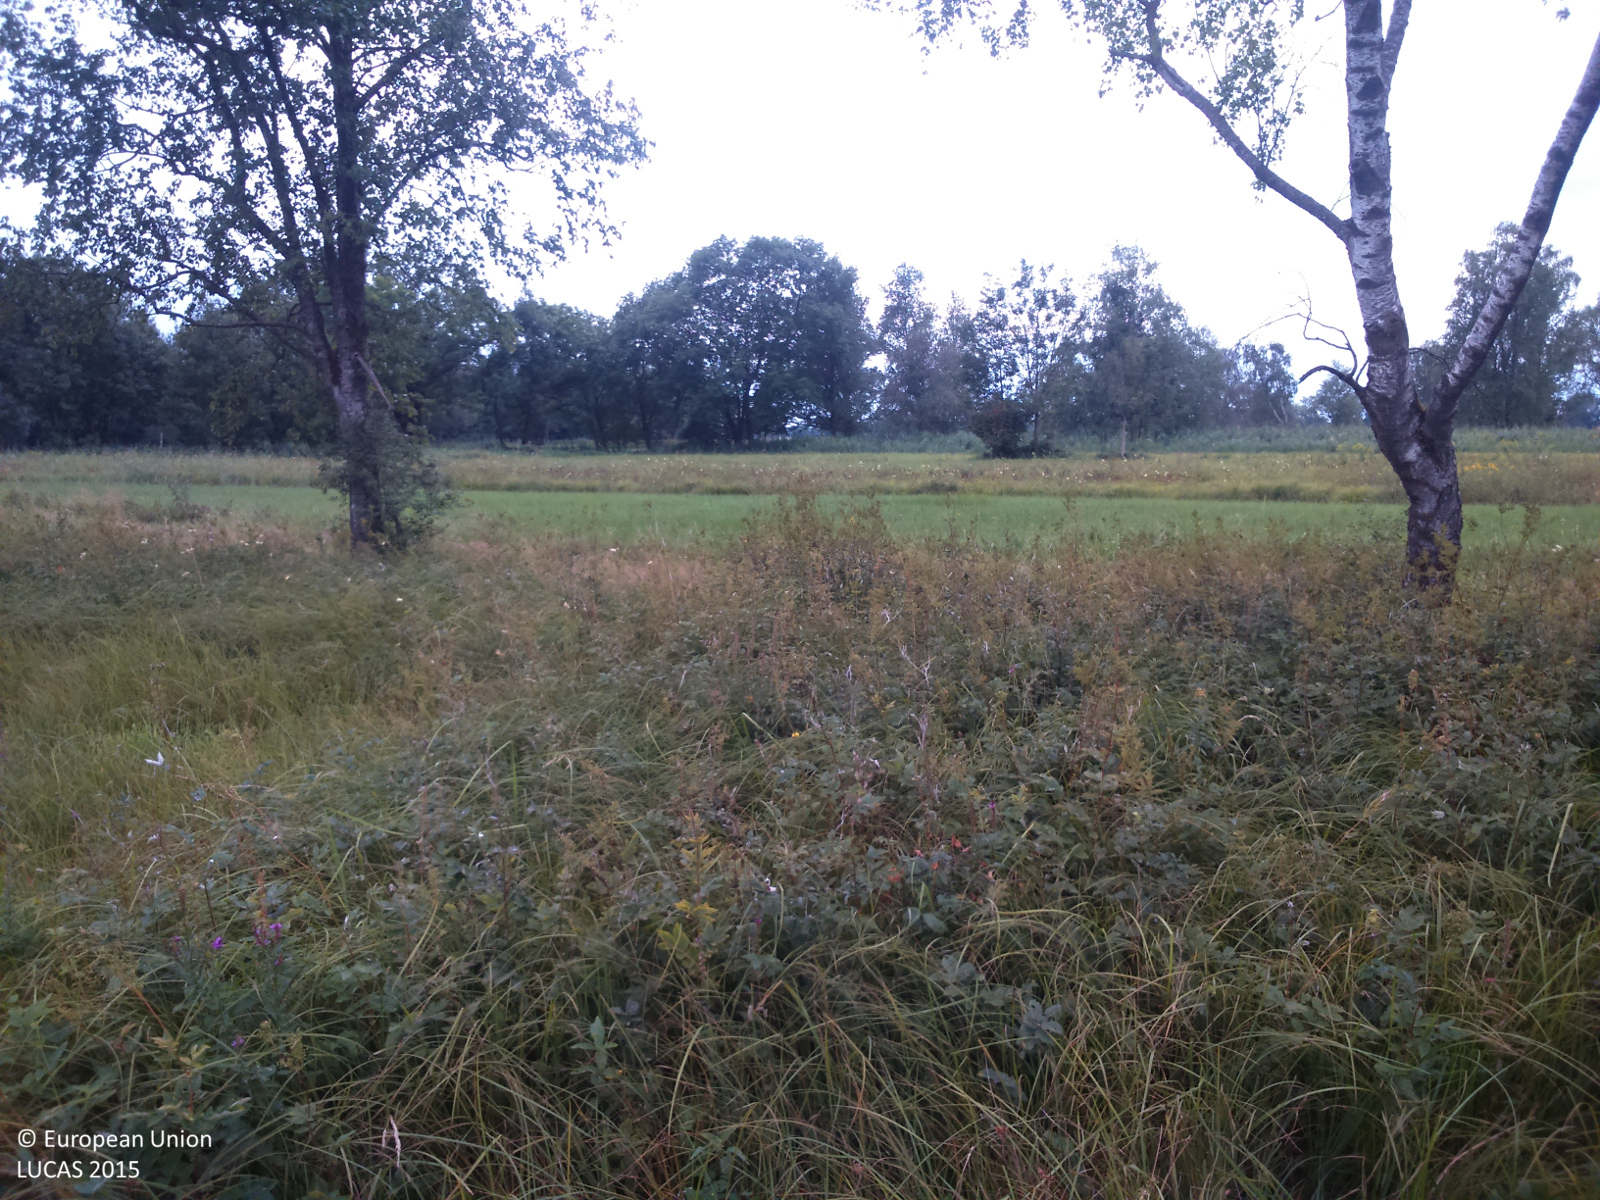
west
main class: Grassland
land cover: Grassland without tree/shrub cover
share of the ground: > 75 %
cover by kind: herbaceous plants 100 %
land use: Agriculture (excluding fallow land and kitchen gardens)
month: August
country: AT
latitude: 47.4672
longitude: 9.6951
